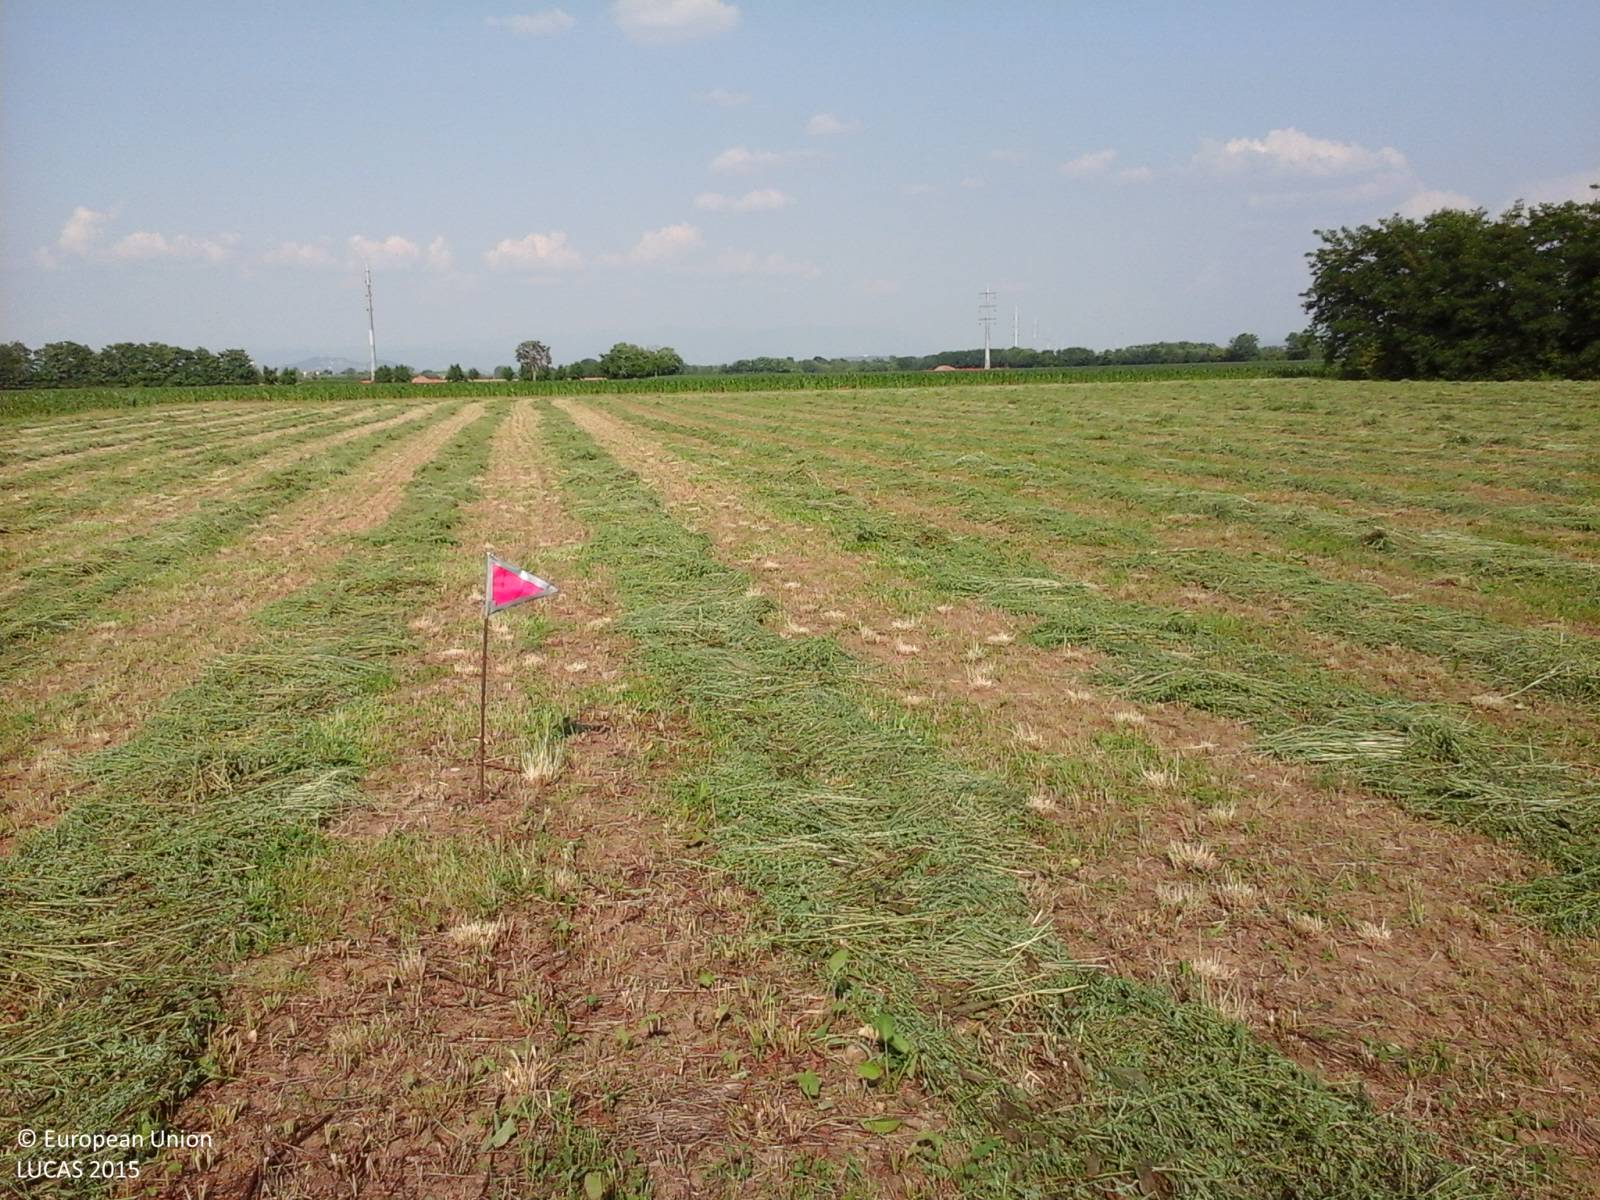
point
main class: Cropland
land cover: Lucerne
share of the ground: > 75 %
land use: Agriculture (excluding fallow land and kitchen gardens)
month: June
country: IT
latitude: 45.9214
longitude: 13.3100
